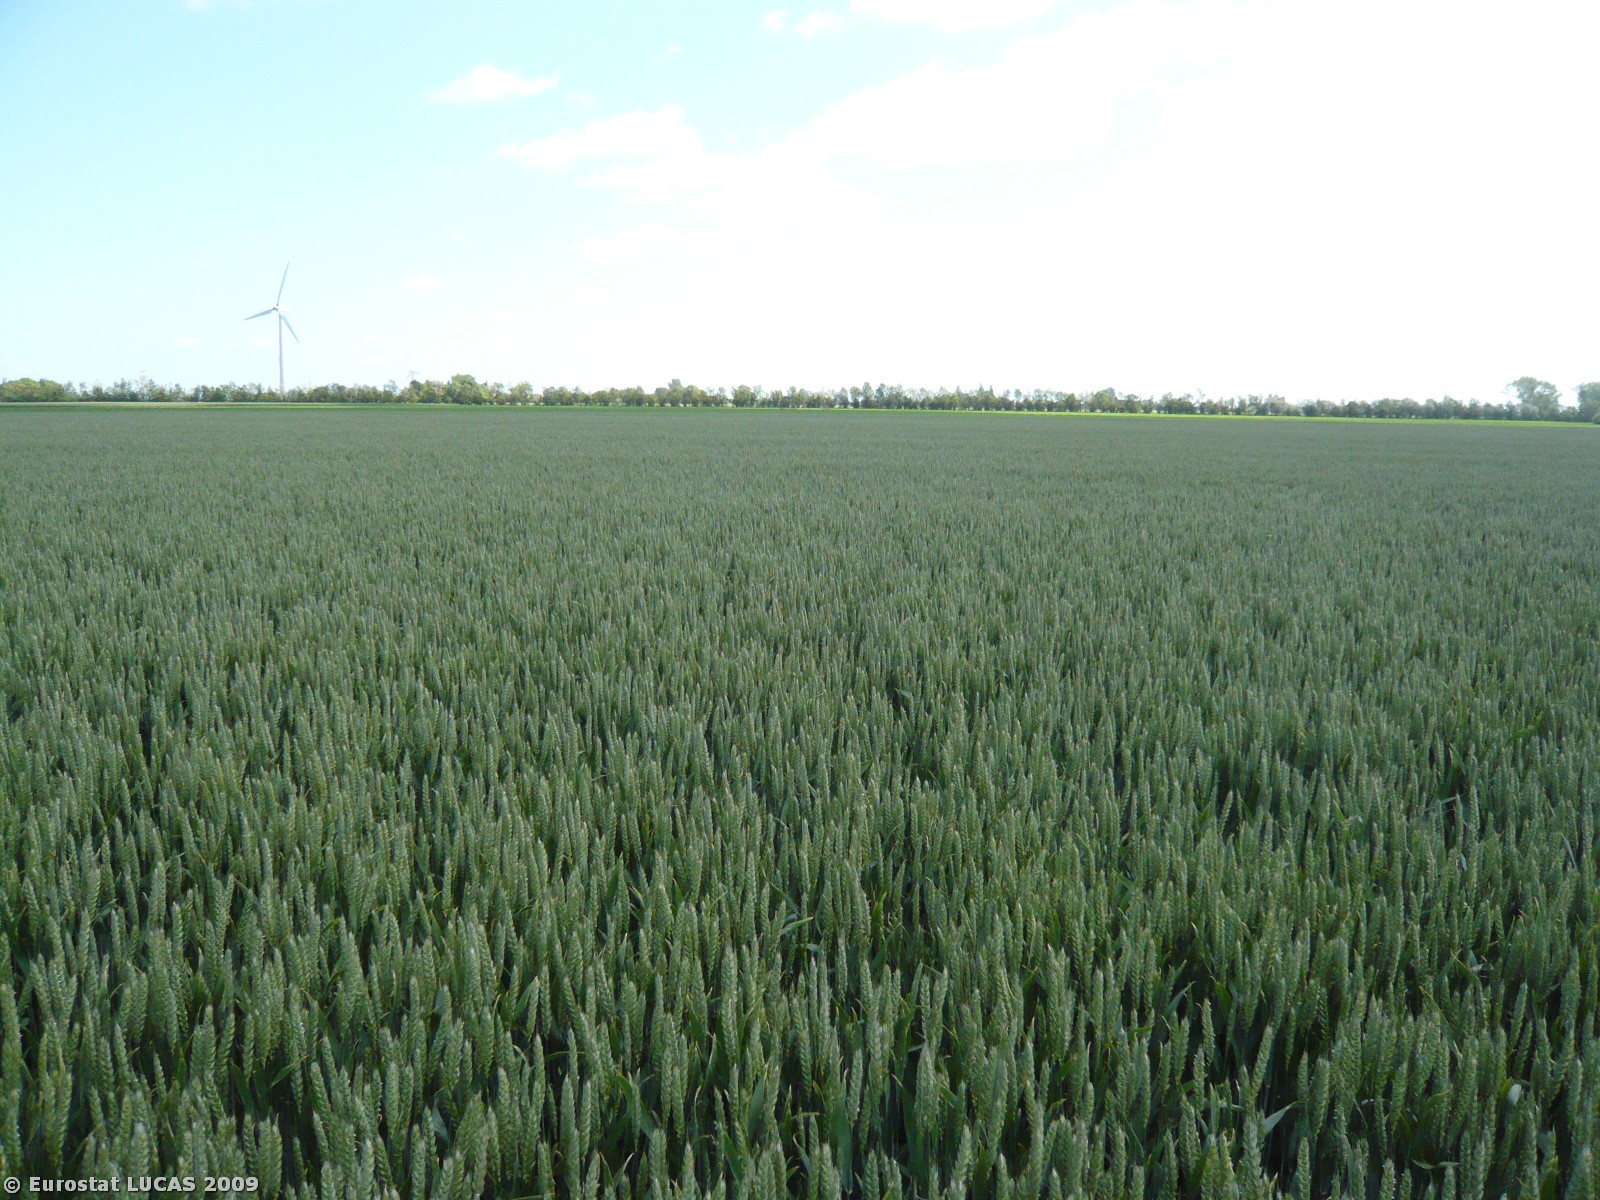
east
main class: Cropland
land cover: Common wheat
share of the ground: > 75 %
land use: Agriculture (excluding fallow land and kitchen gardens)
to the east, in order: Common wheat; Sugar beet
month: June
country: DK
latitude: 54.7809
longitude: 11.1031
